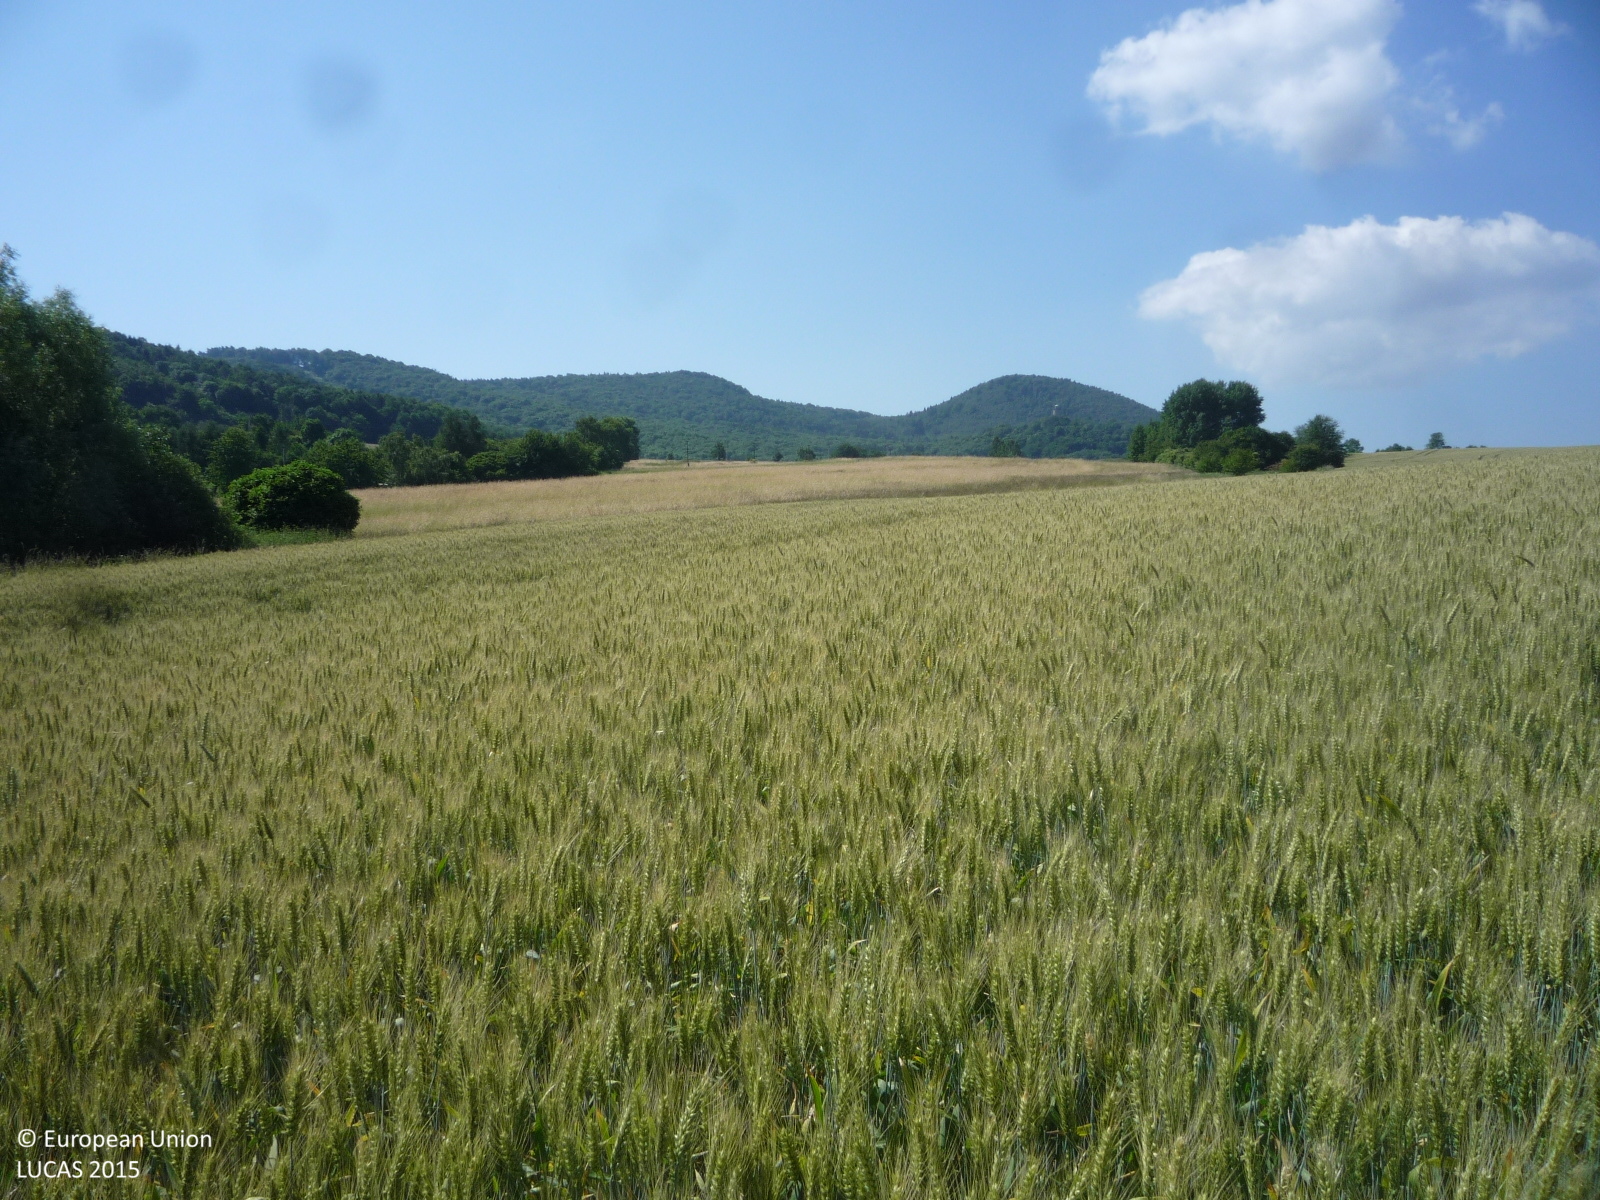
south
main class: Cropland
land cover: Common wheat
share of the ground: > 75 %
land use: Agriculture (excluding fallow land and kitchen gardens)
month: July
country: CZ
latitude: 50.5682
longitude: 13.8835
